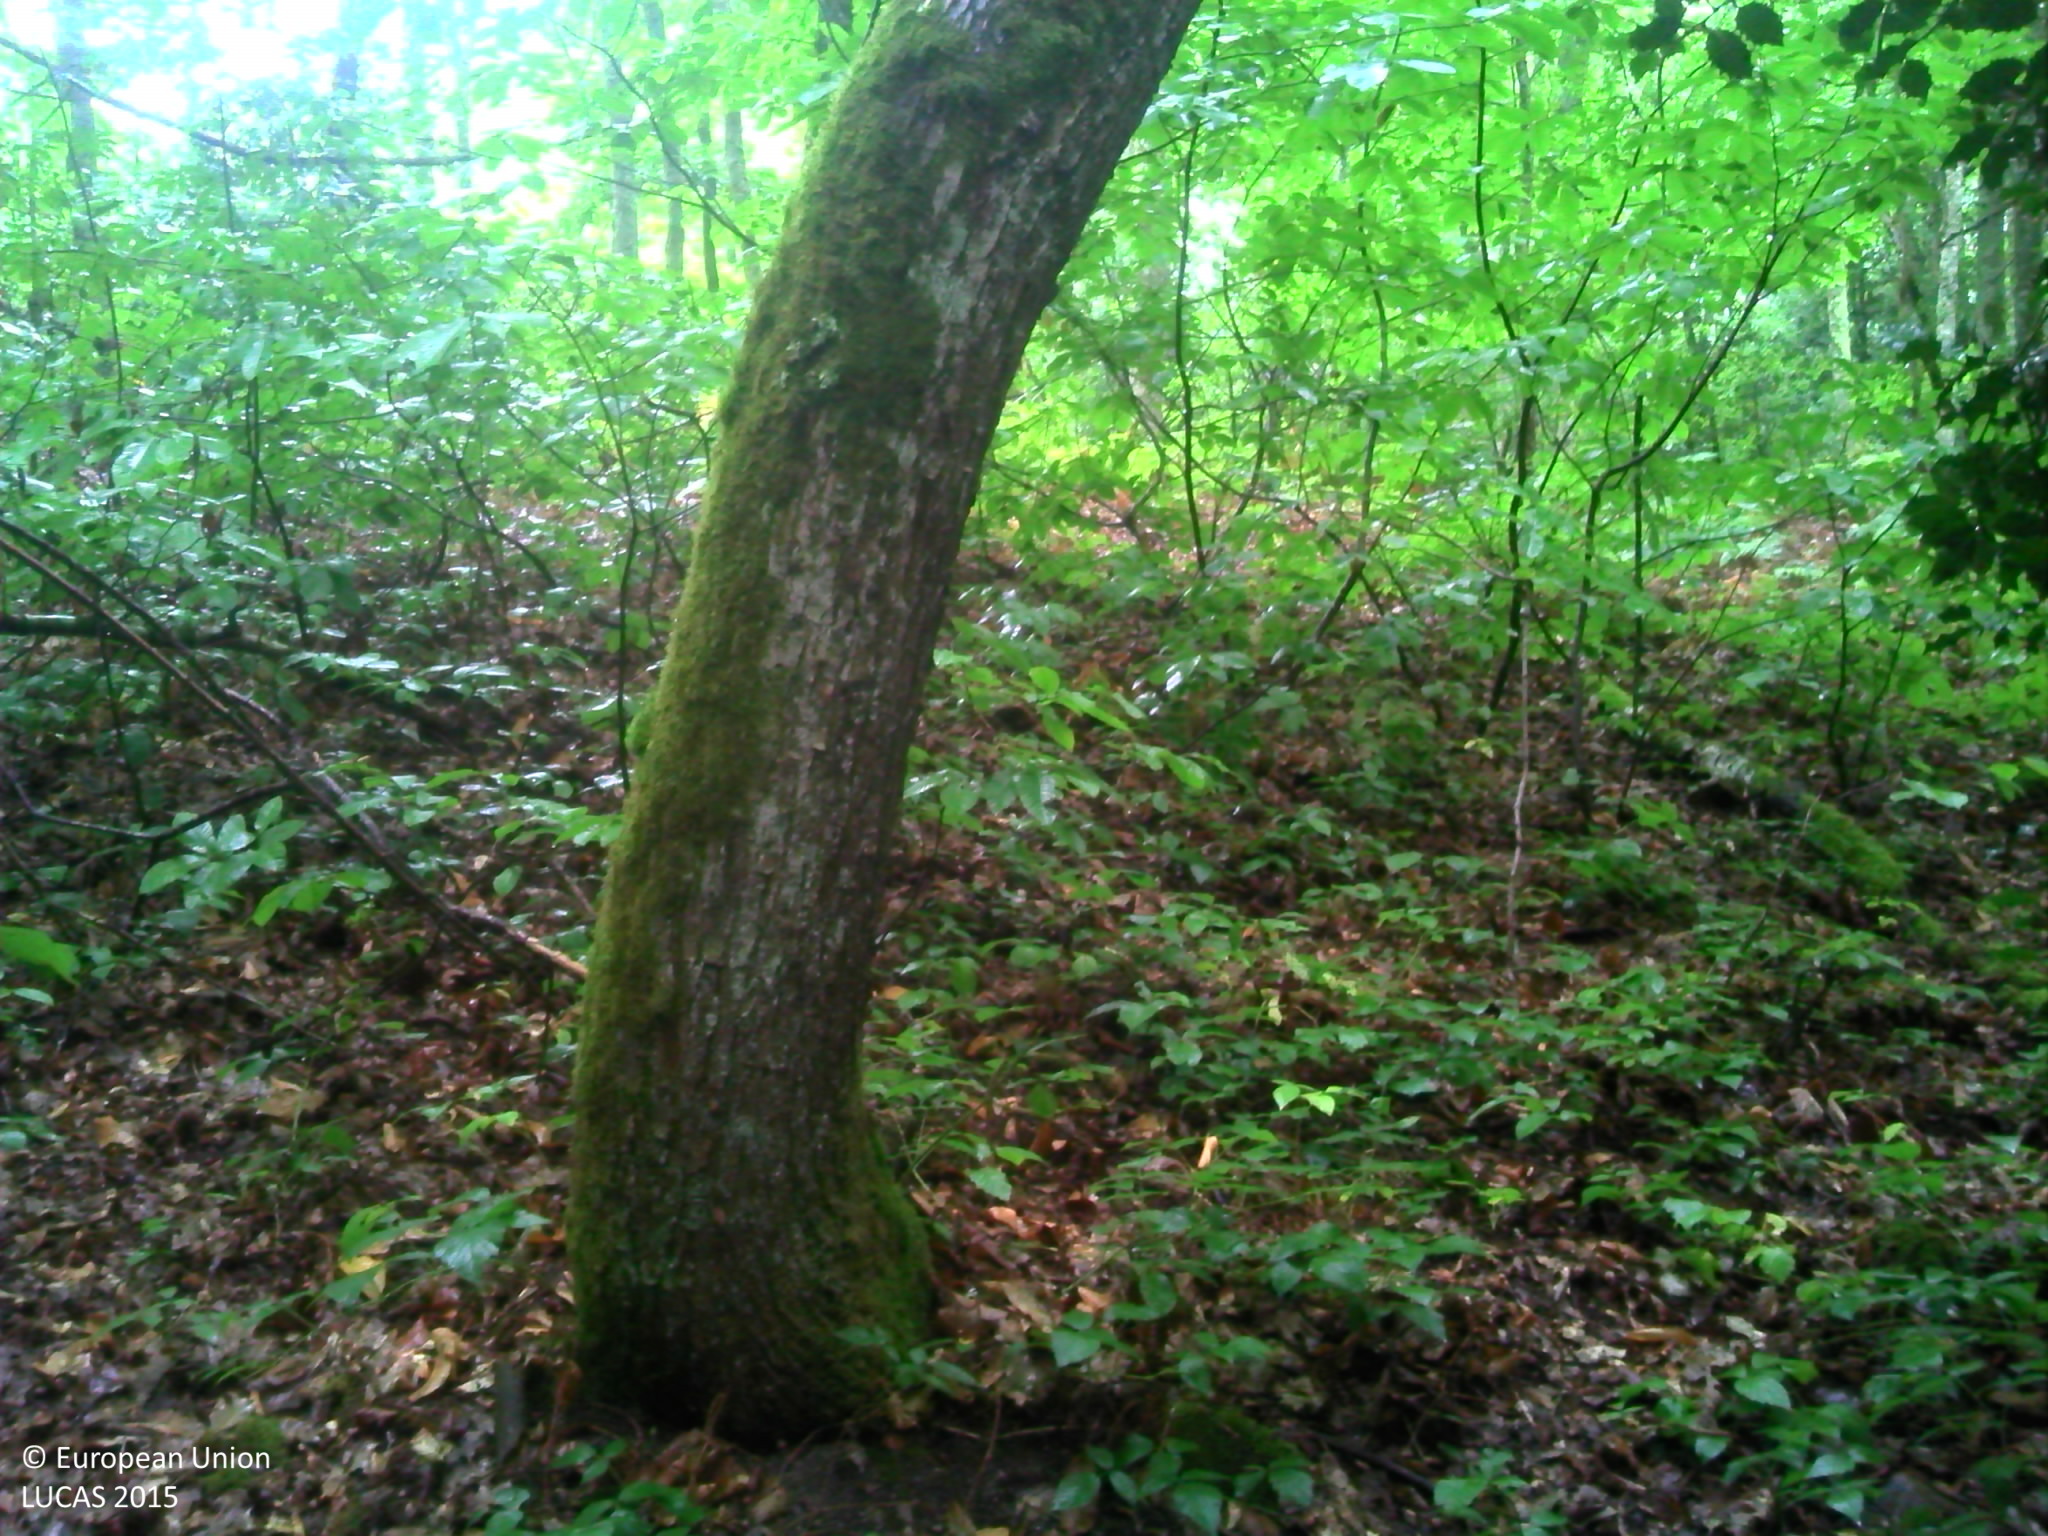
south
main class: Woodland
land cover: Broadleaved woodland
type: thermophilous deciduous forest
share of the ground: > 75 %
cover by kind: broadleaved forest trees 65 %, shrubs 15 %, herbaceous plants 15 %, lichens and mosses 5 %
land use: Forestry
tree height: > 5 m
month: August
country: FR
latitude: 46.3224
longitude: 2.2406
